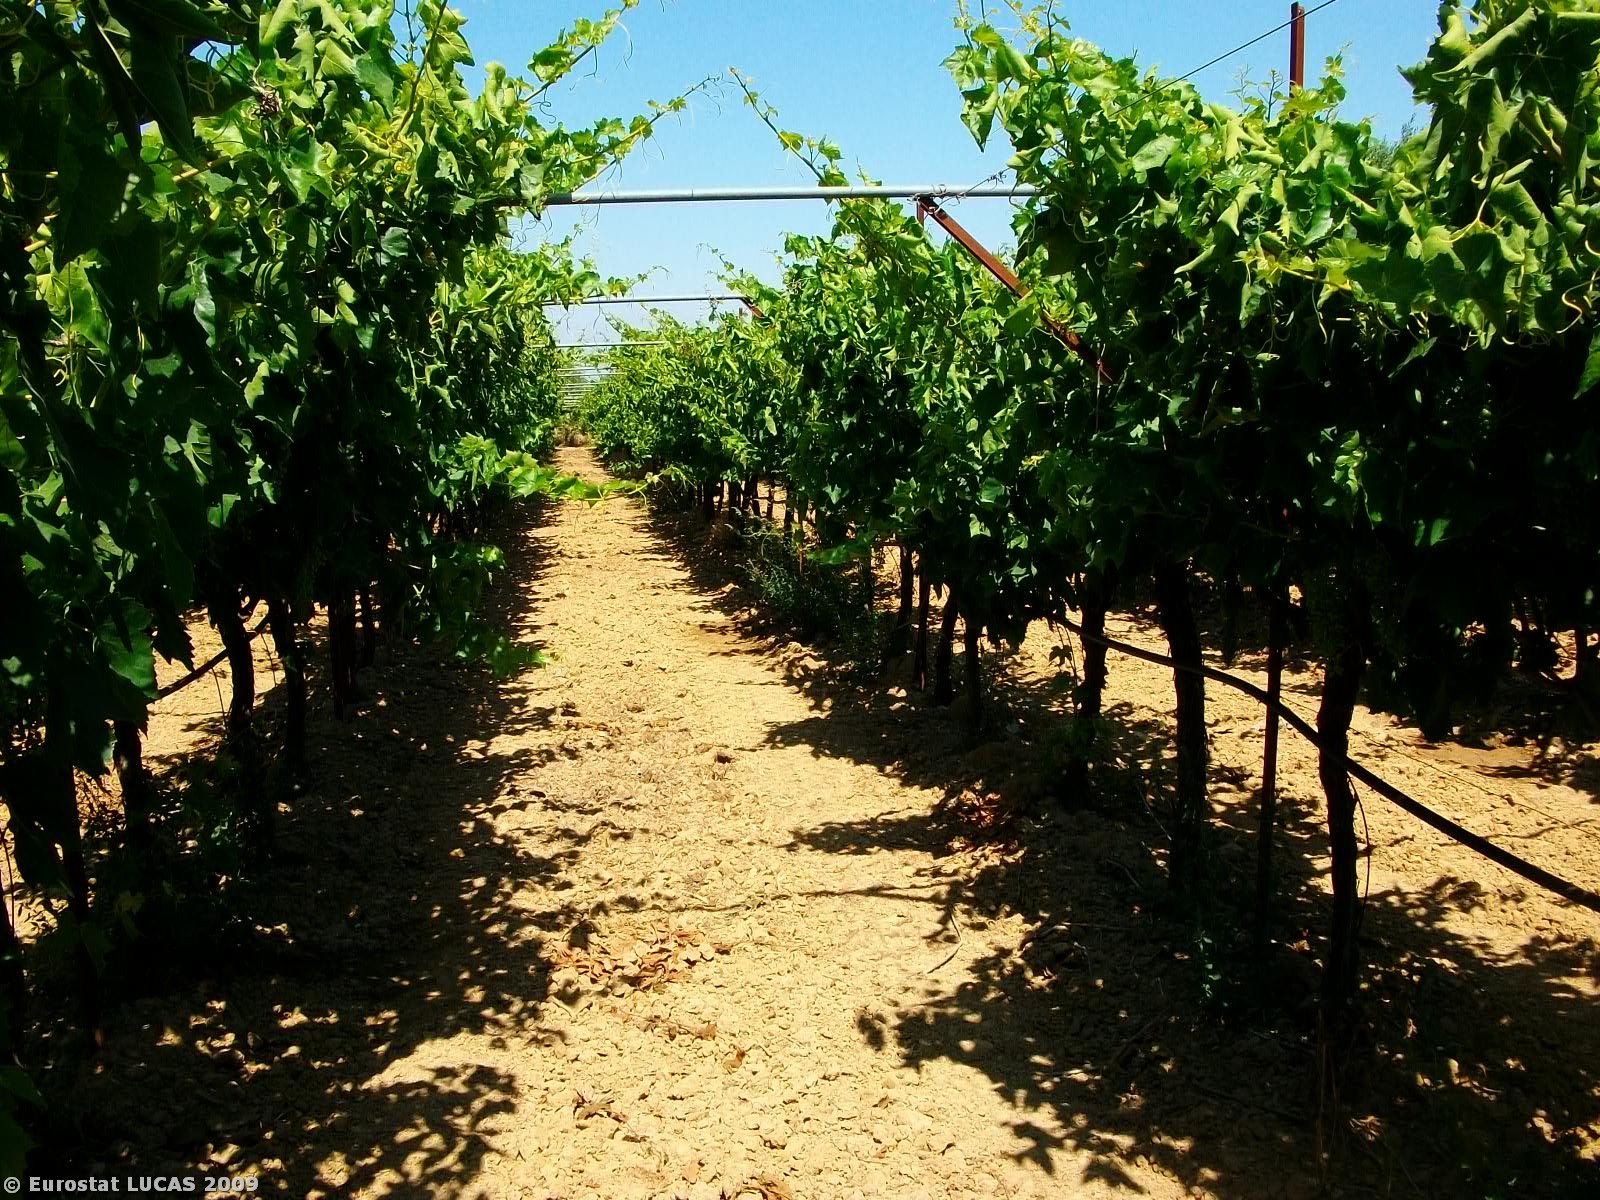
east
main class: Cropland
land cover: Vineyards
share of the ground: > 75 %
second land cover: Bare land
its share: > 75 %
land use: Agriculture (excluding fallow land and kitchen gardens)
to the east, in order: Vineyards; Bare land; Olive groves; Bare land; Tracks; Olive groves; Bare land; Paved roads, cycling and walking lanes; Olive groves; Bare land
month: June
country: GR
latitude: 35.0230
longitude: 25.1001
